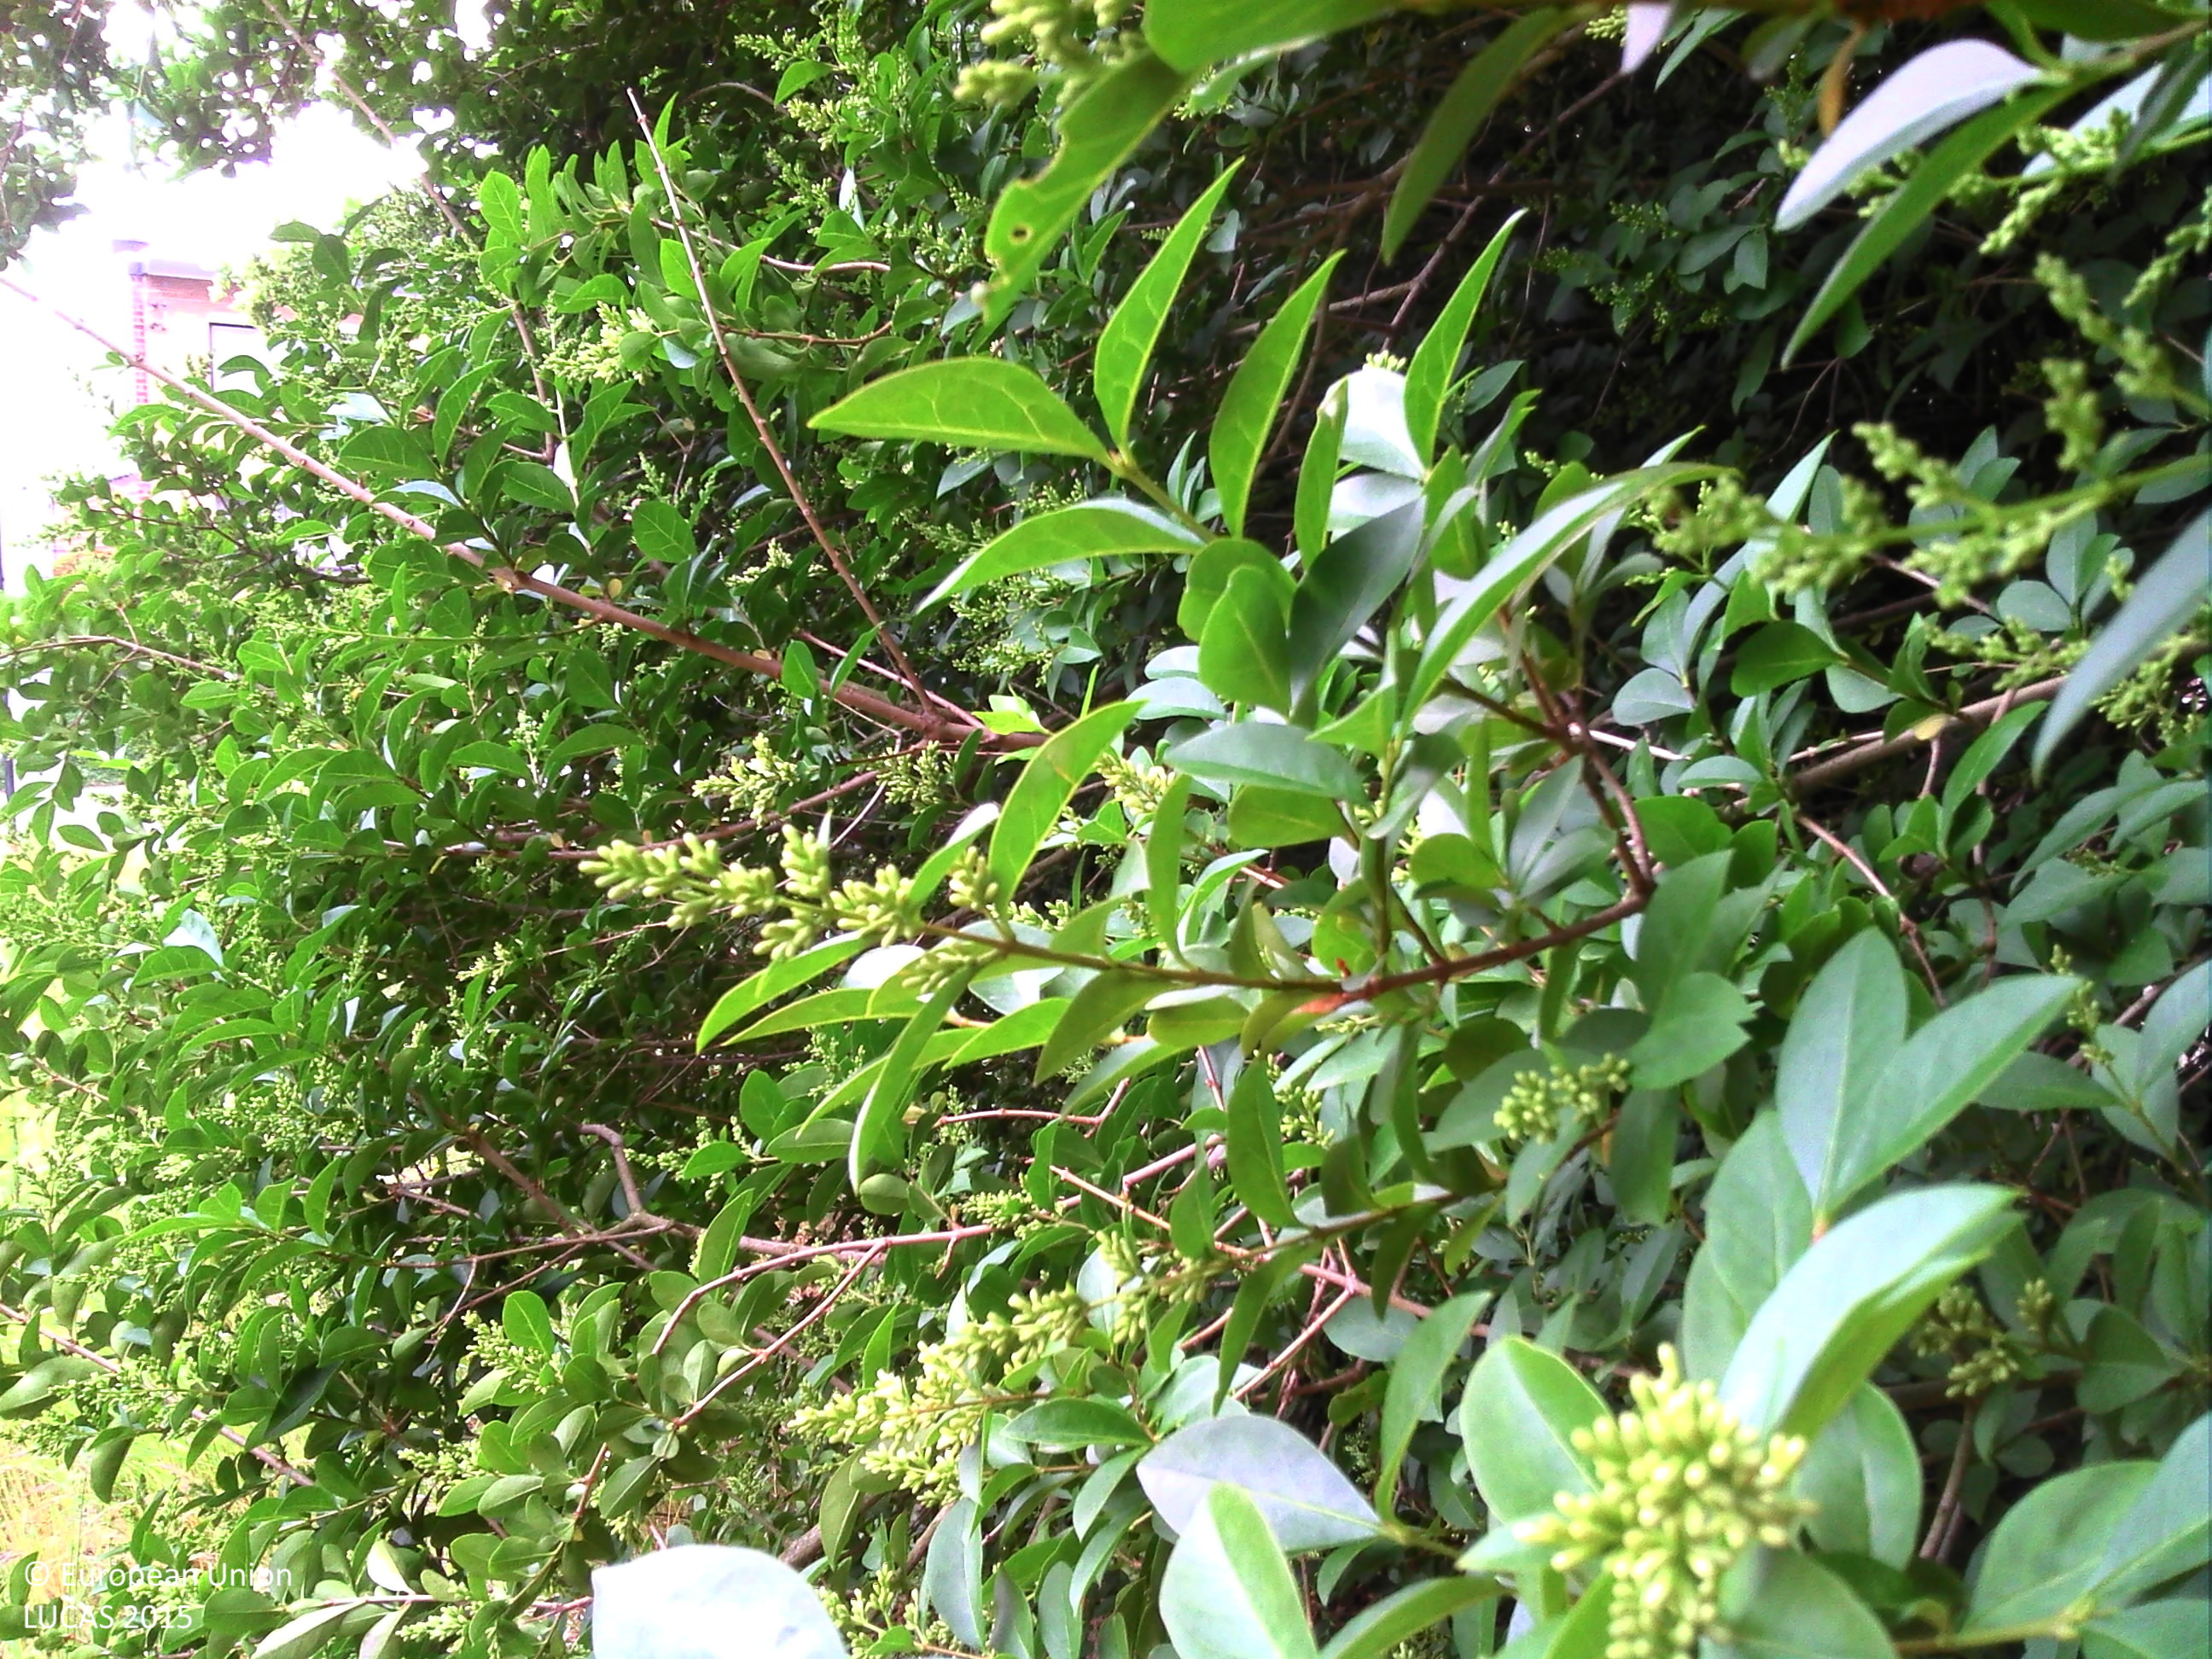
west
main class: Grassland
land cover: Grassland without tree/shrub cover
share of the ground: > 75 %
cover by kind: herbaceous plants 100 %
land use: Abandoned areas
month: June
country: BE
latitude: 50.6521
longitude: 5.4579
